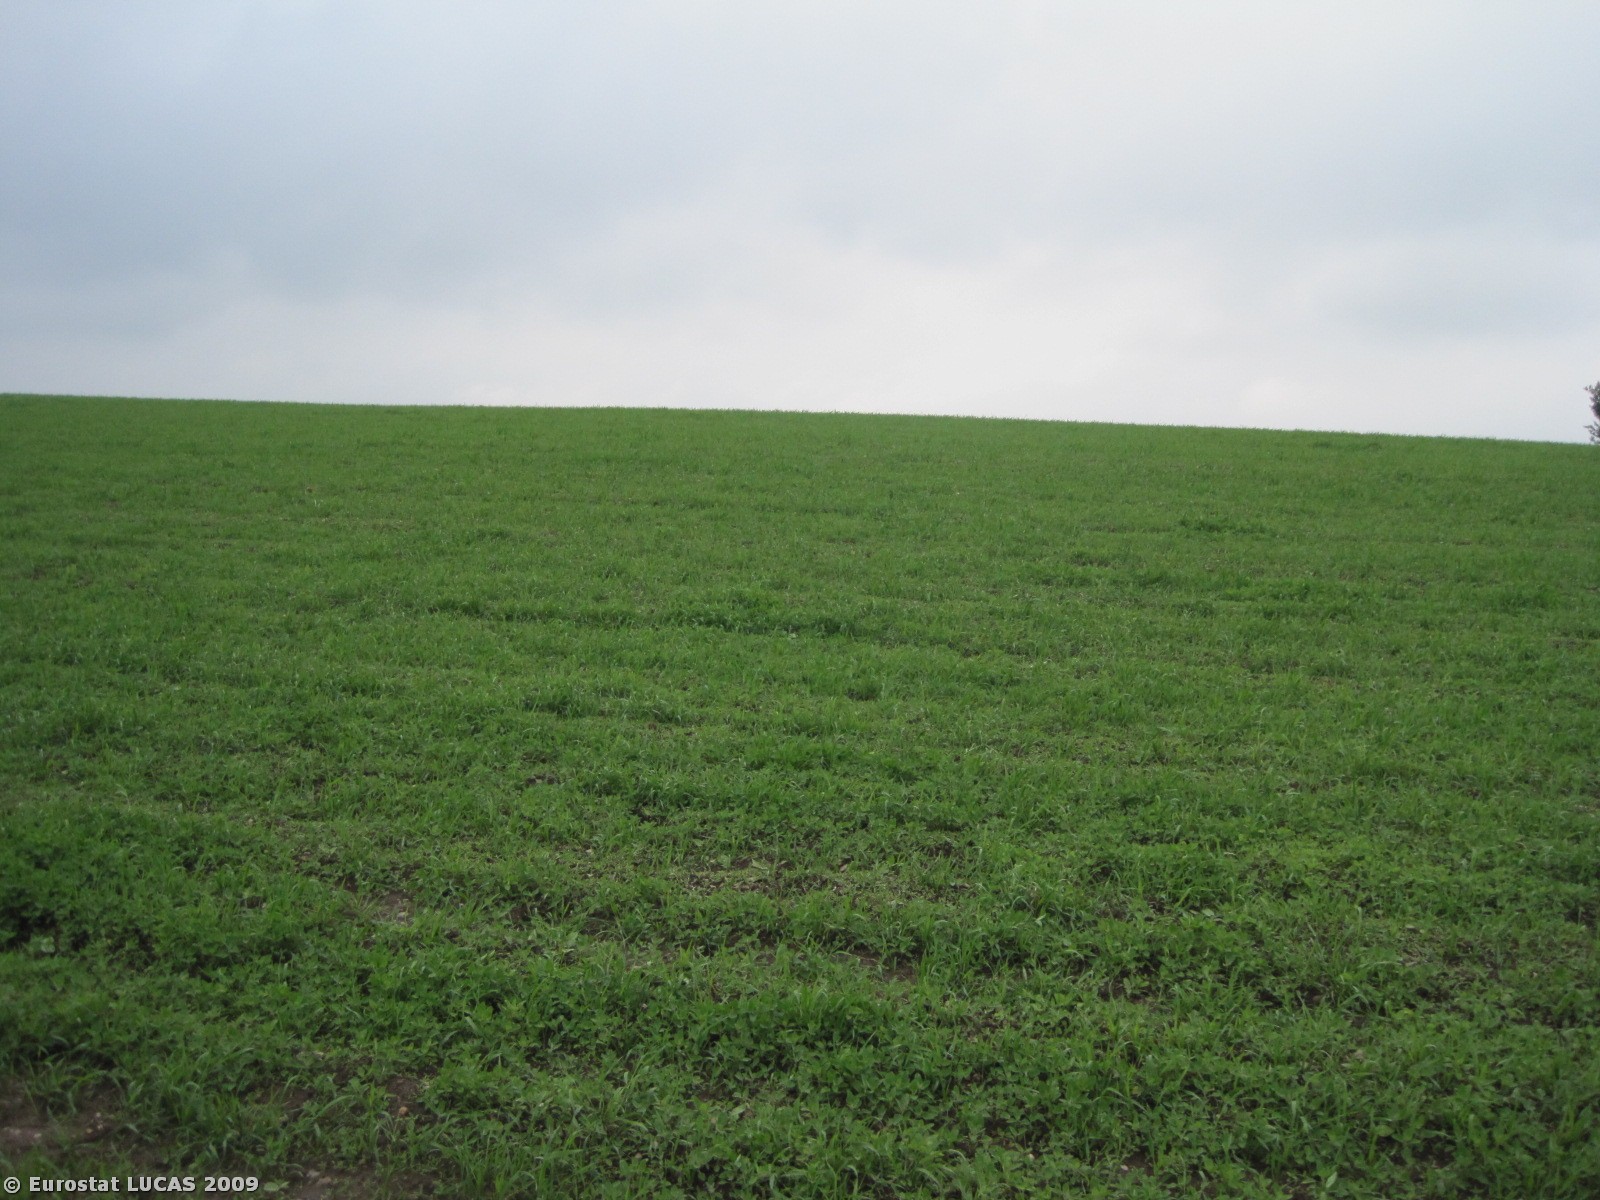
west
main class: Grassland
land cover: Grassland without tree/shrub cover
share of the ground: > 75 %
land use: Agriculture (excluding fallow land and kitchen gardens)
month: May
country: DK
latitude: 56.4033
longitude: 9.8220
